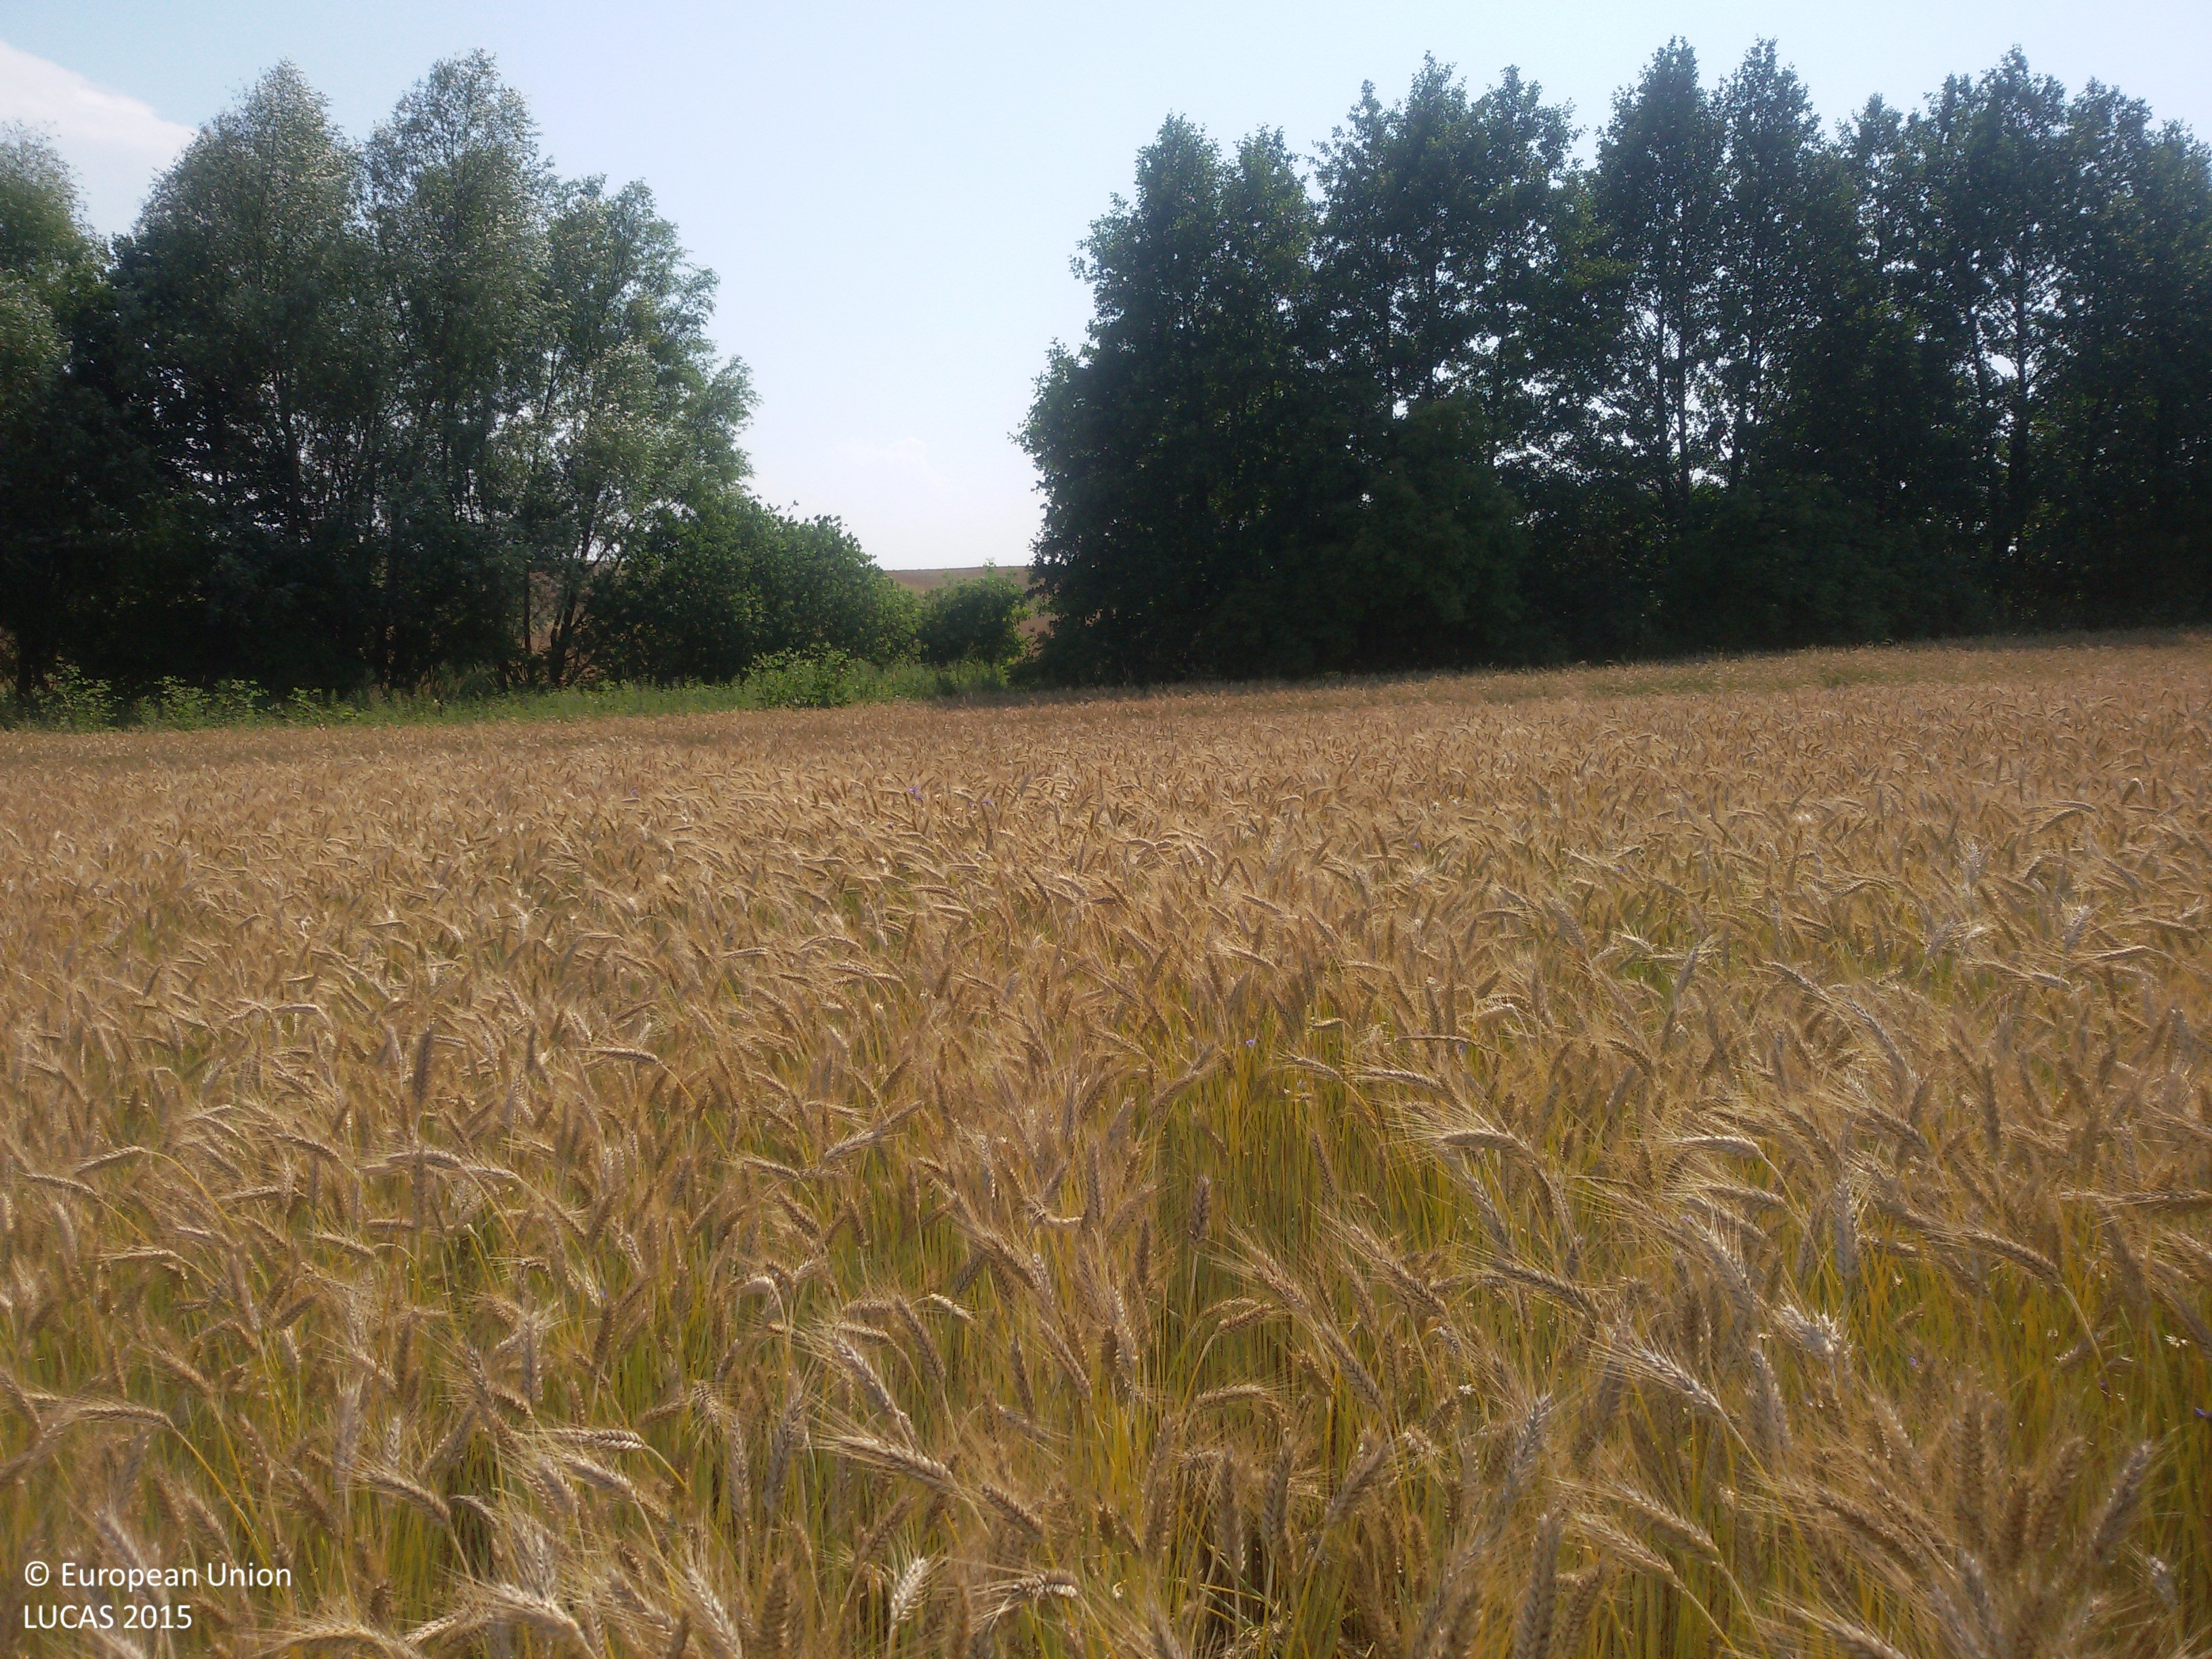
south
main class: Cropland
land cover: Triticale
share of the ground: > 75 %
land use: Agriculture (excluding fallow land and kitchen gardens)
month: July
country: PL
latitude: 53.3361
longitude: 17.7172
